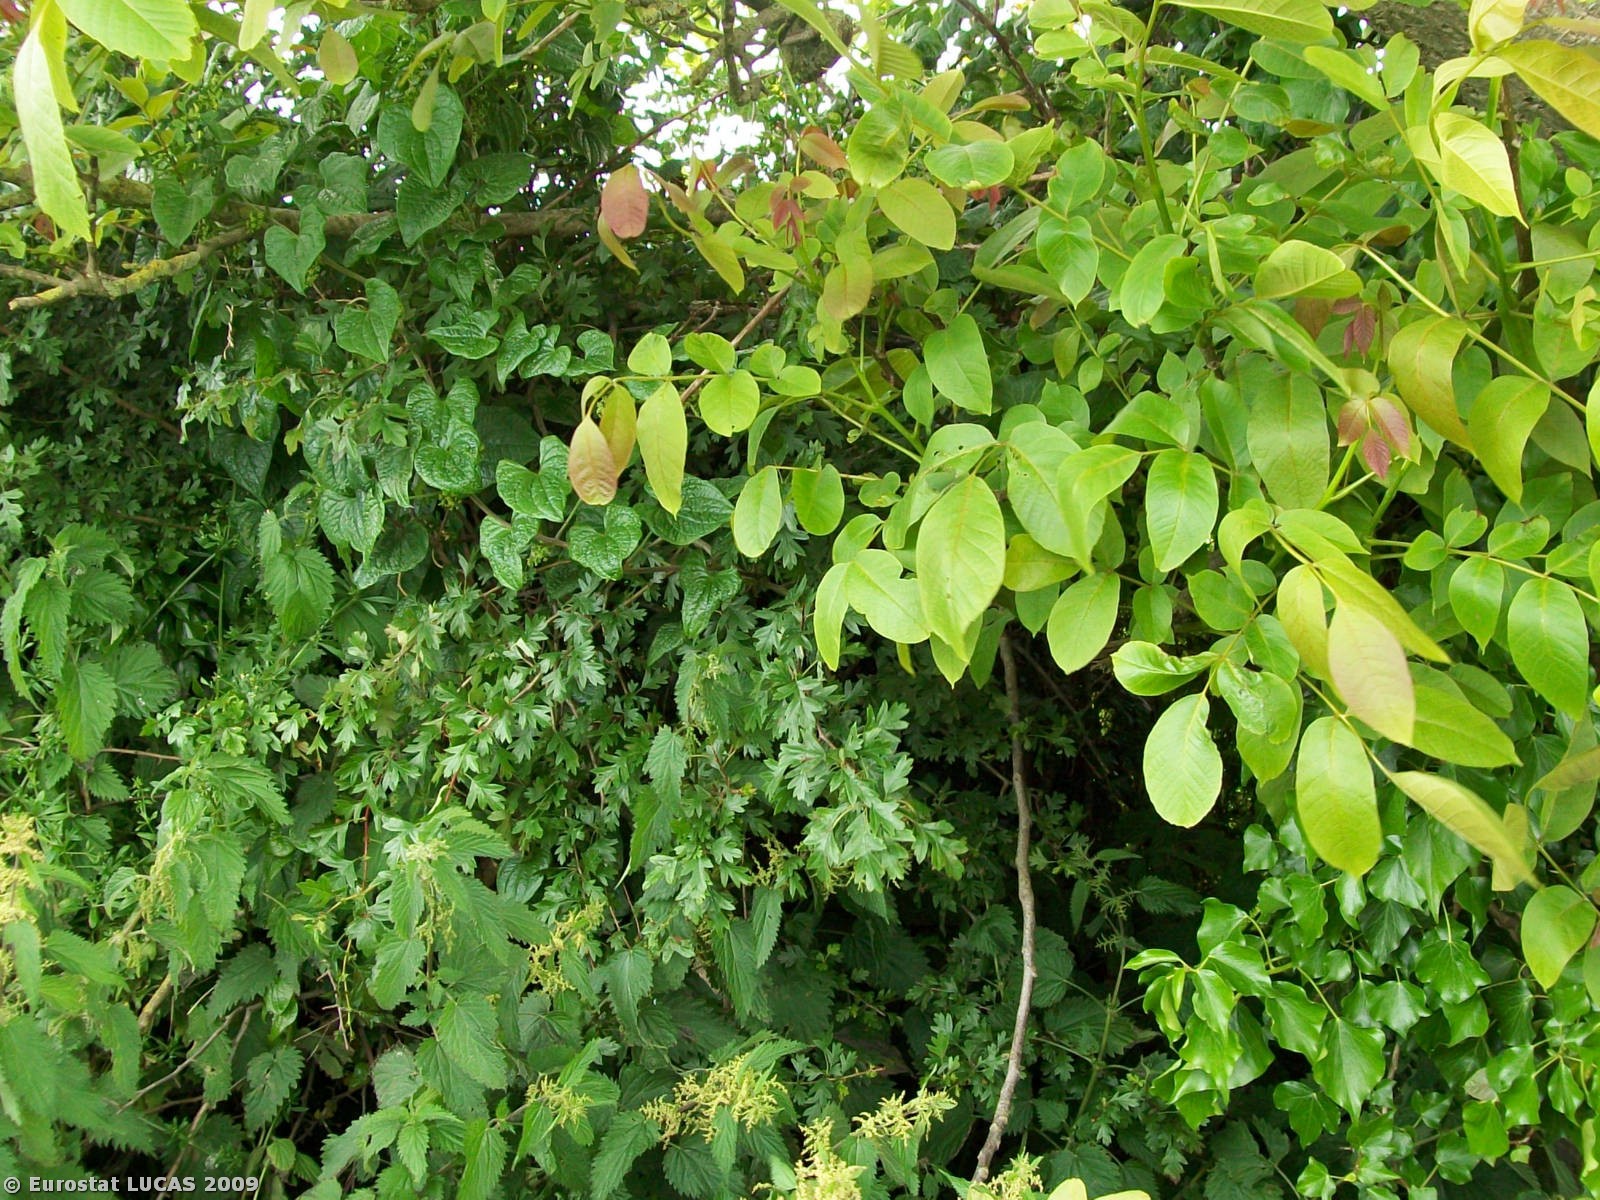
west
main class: Cropland
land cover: Dry pulses
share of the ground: > 75 %
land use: Agriculture (excluding fallow land and kitchen gardens)
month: June
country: GB
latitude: 50.8062
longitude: -2.1364
